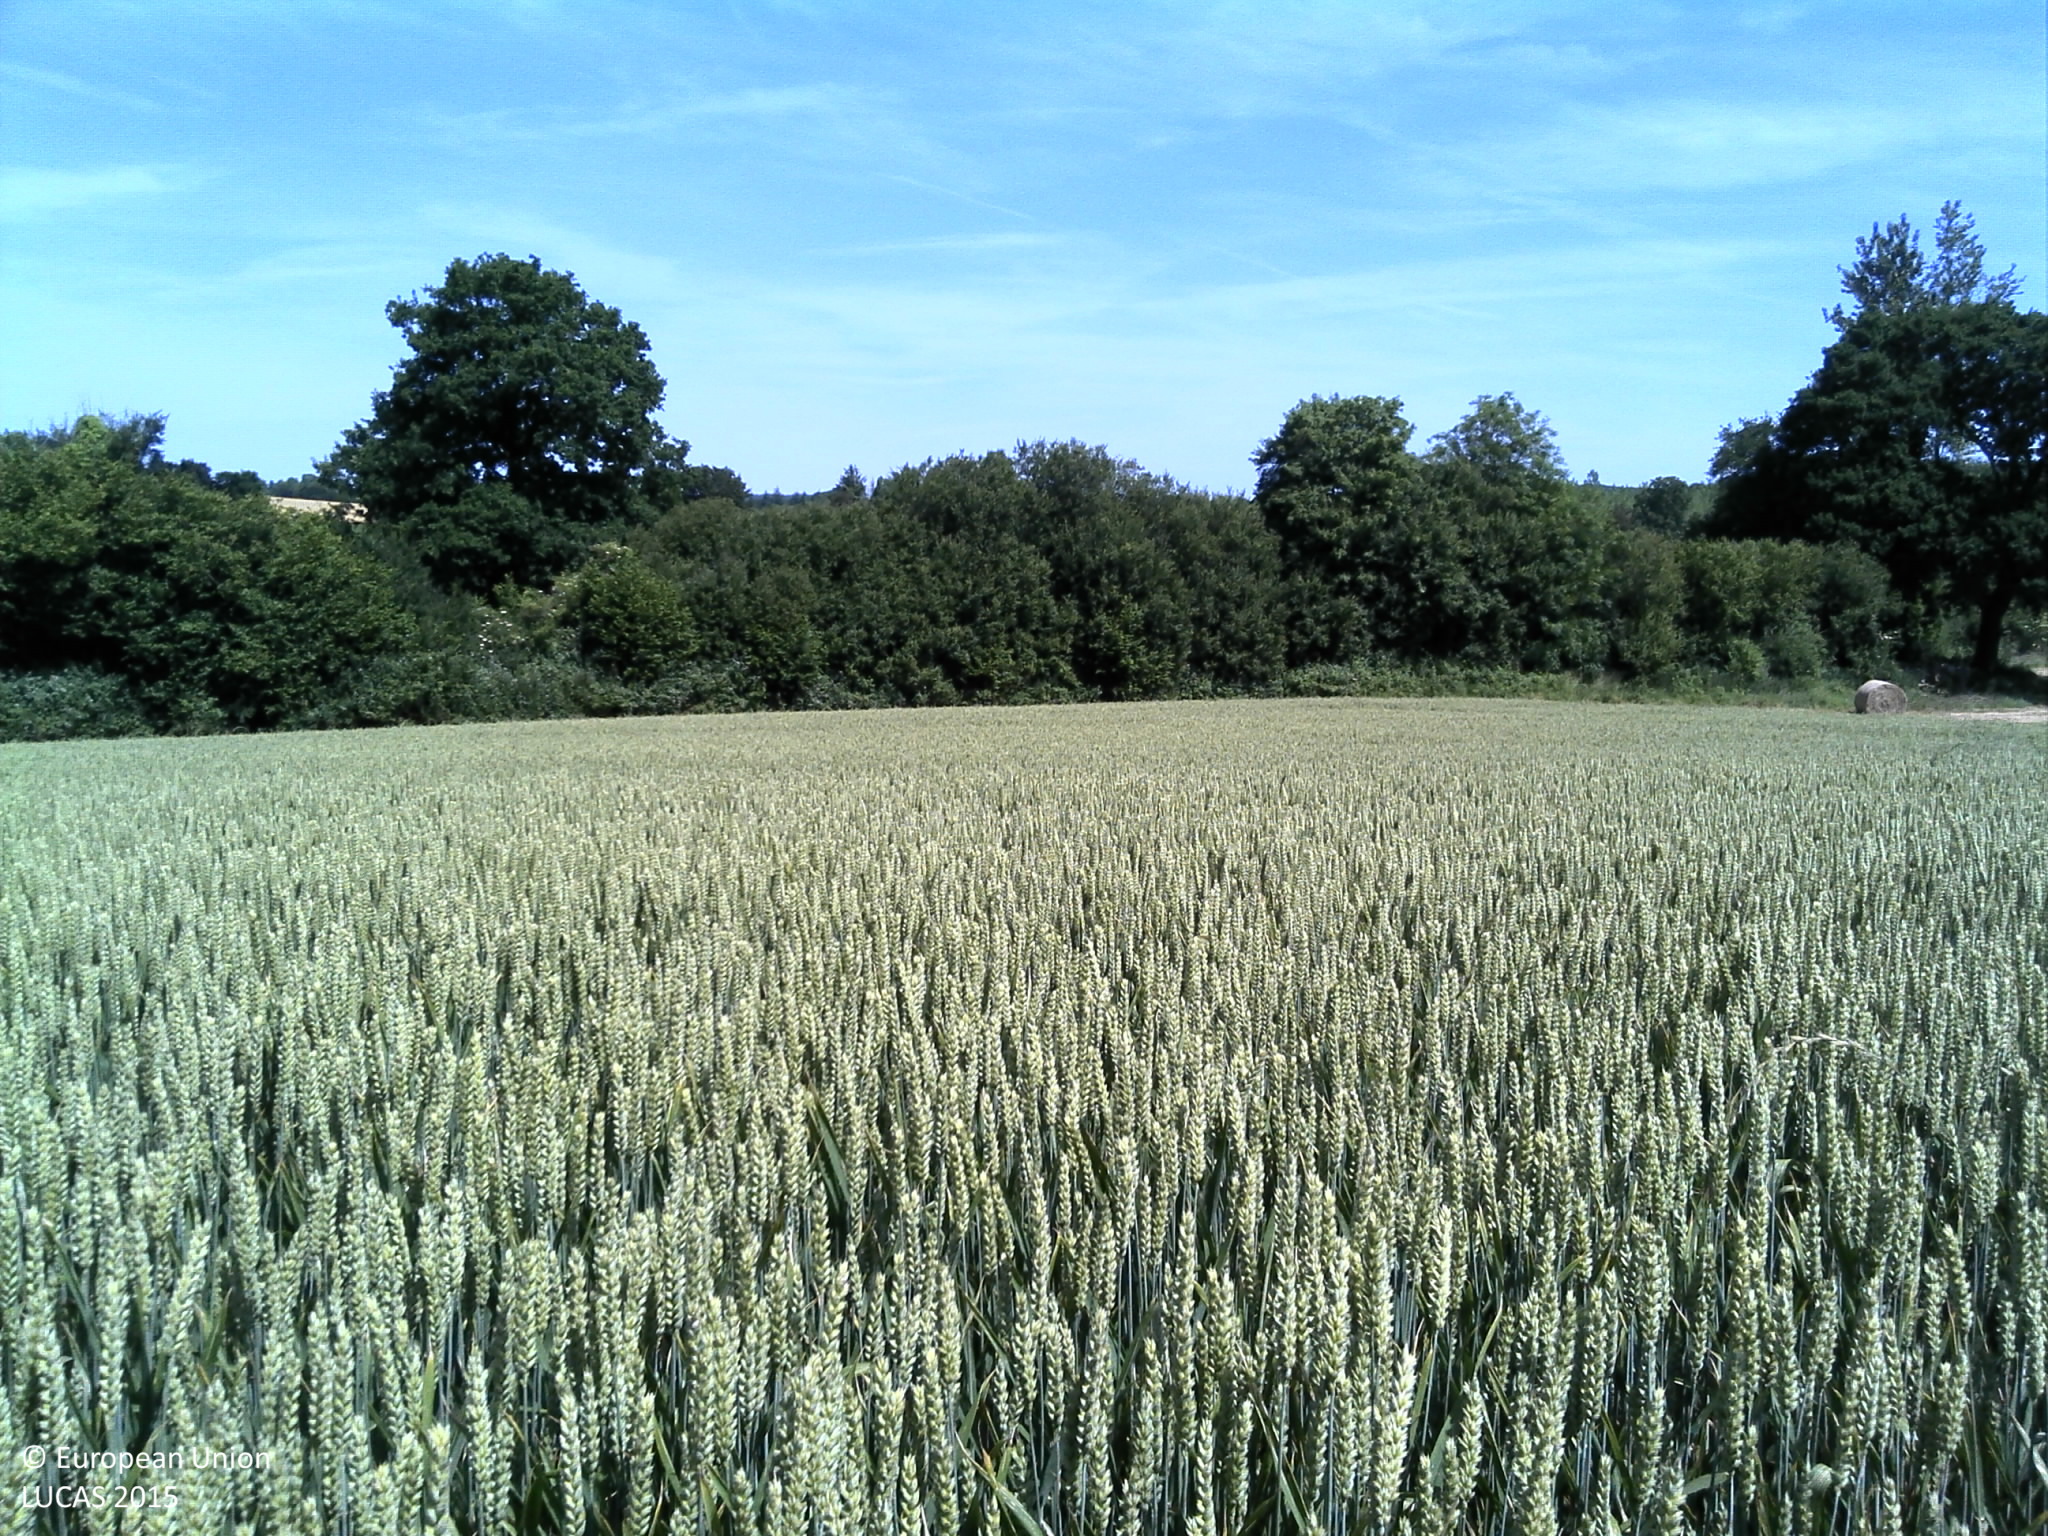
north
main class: Cropland
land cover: Common wheat
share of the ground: > 75 %
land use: Agriculture (excluding fallow land and kitchen gardens)
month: June
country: FR
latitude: 48.3523
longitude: -3.6706
